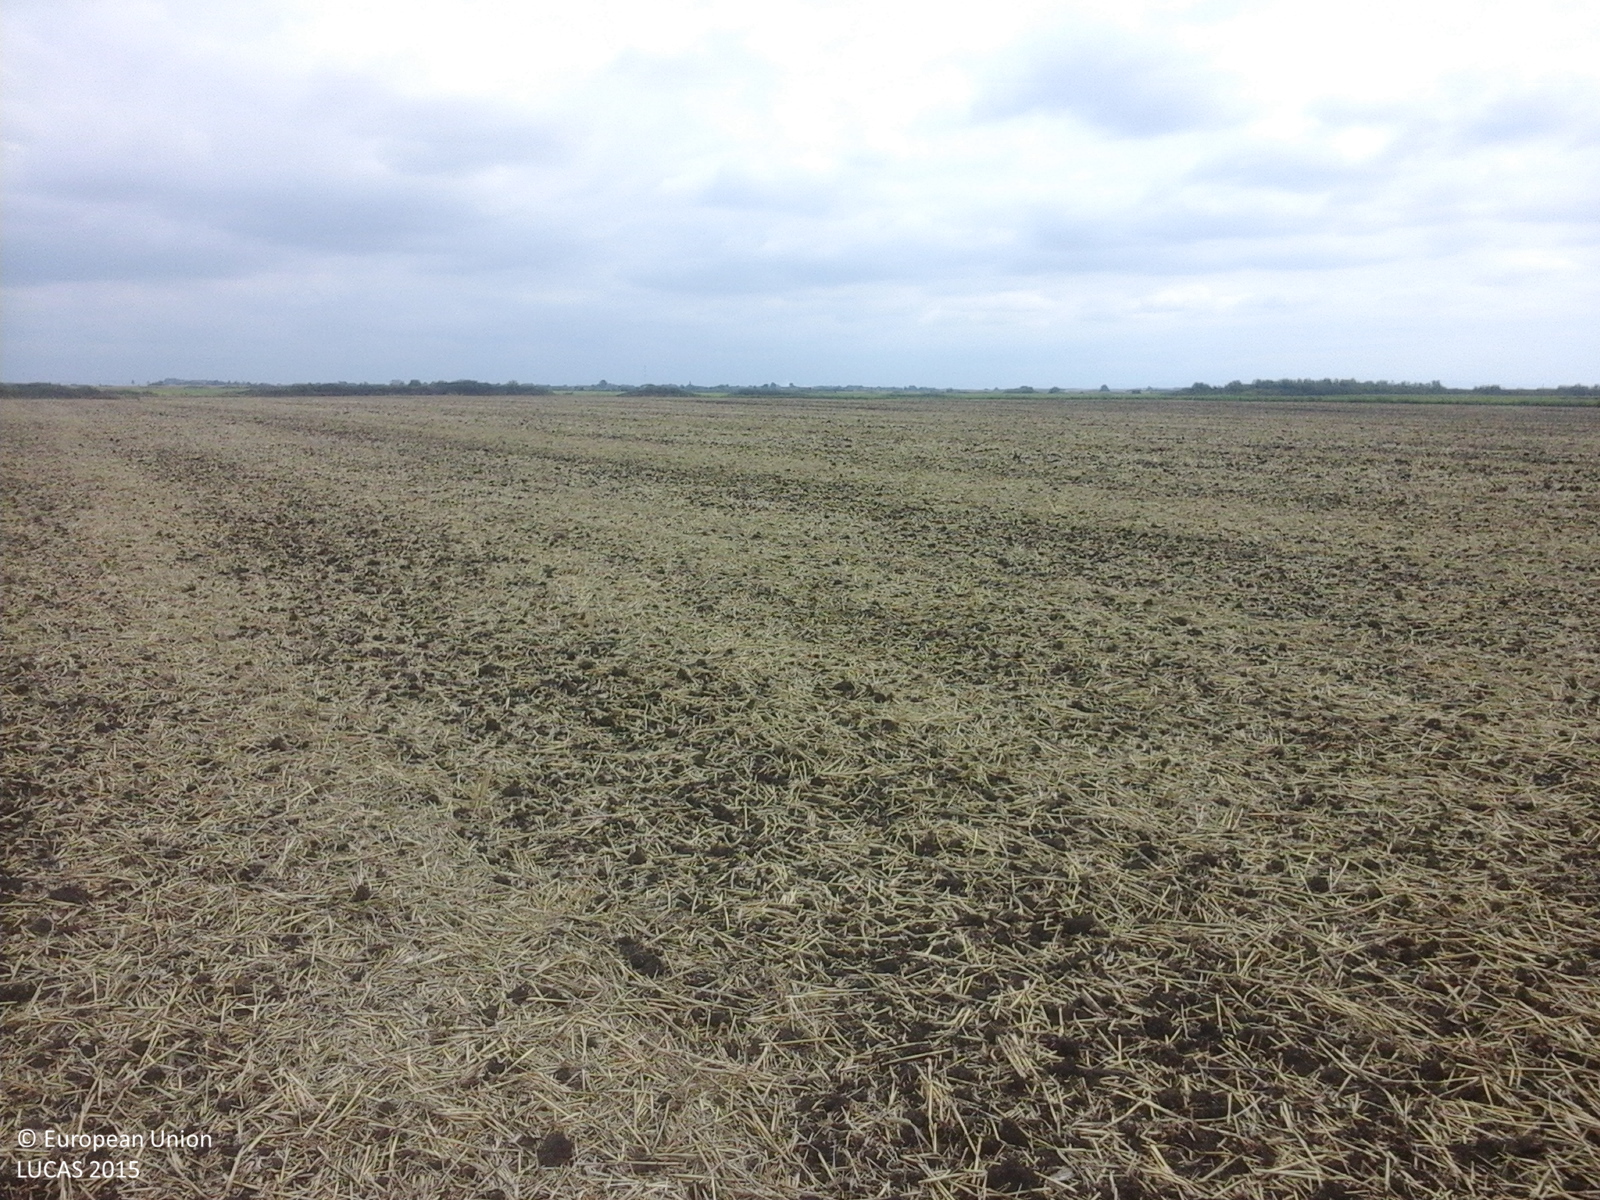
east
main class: Cropland
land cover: Common wheat
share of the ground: 10 - 25 %
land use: Agriculture (excluding fallow land and kitchen gardens)
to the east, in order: Common wheat
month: August
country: RO
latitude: 45.5008
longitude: 21.2531
